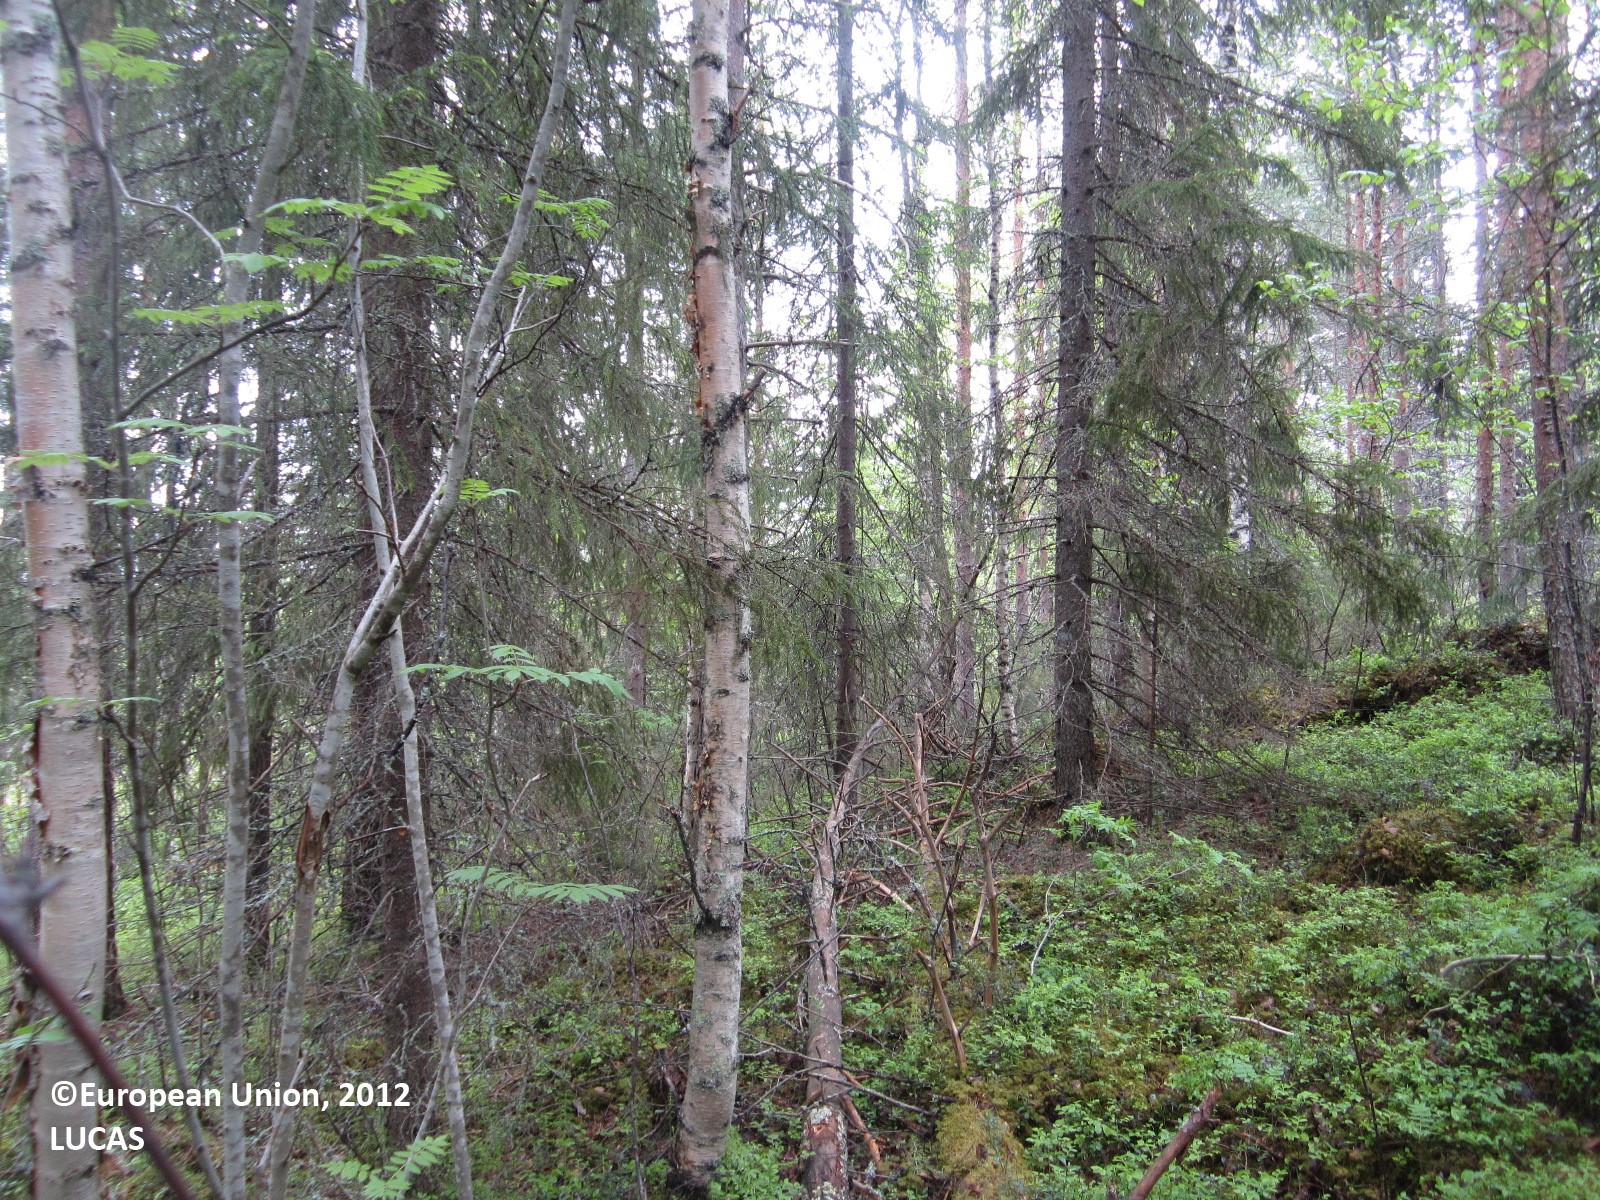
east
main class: Woodland
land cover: Pine dominated mixed woodland
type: boreal forest
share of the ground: > 75 %
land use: Forestry
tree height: > 5 m
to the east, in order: Pine dominated mixed woodland; Fences; Pine dominated mixed woodland; Shrubland with sparse tree cover; Pine dominated mixed woodland; Pine dominated coniferous woodland; Tracks; Pine dominated coniferous woodland
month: June
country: FI
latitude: 64.6172
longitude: 28.6846
